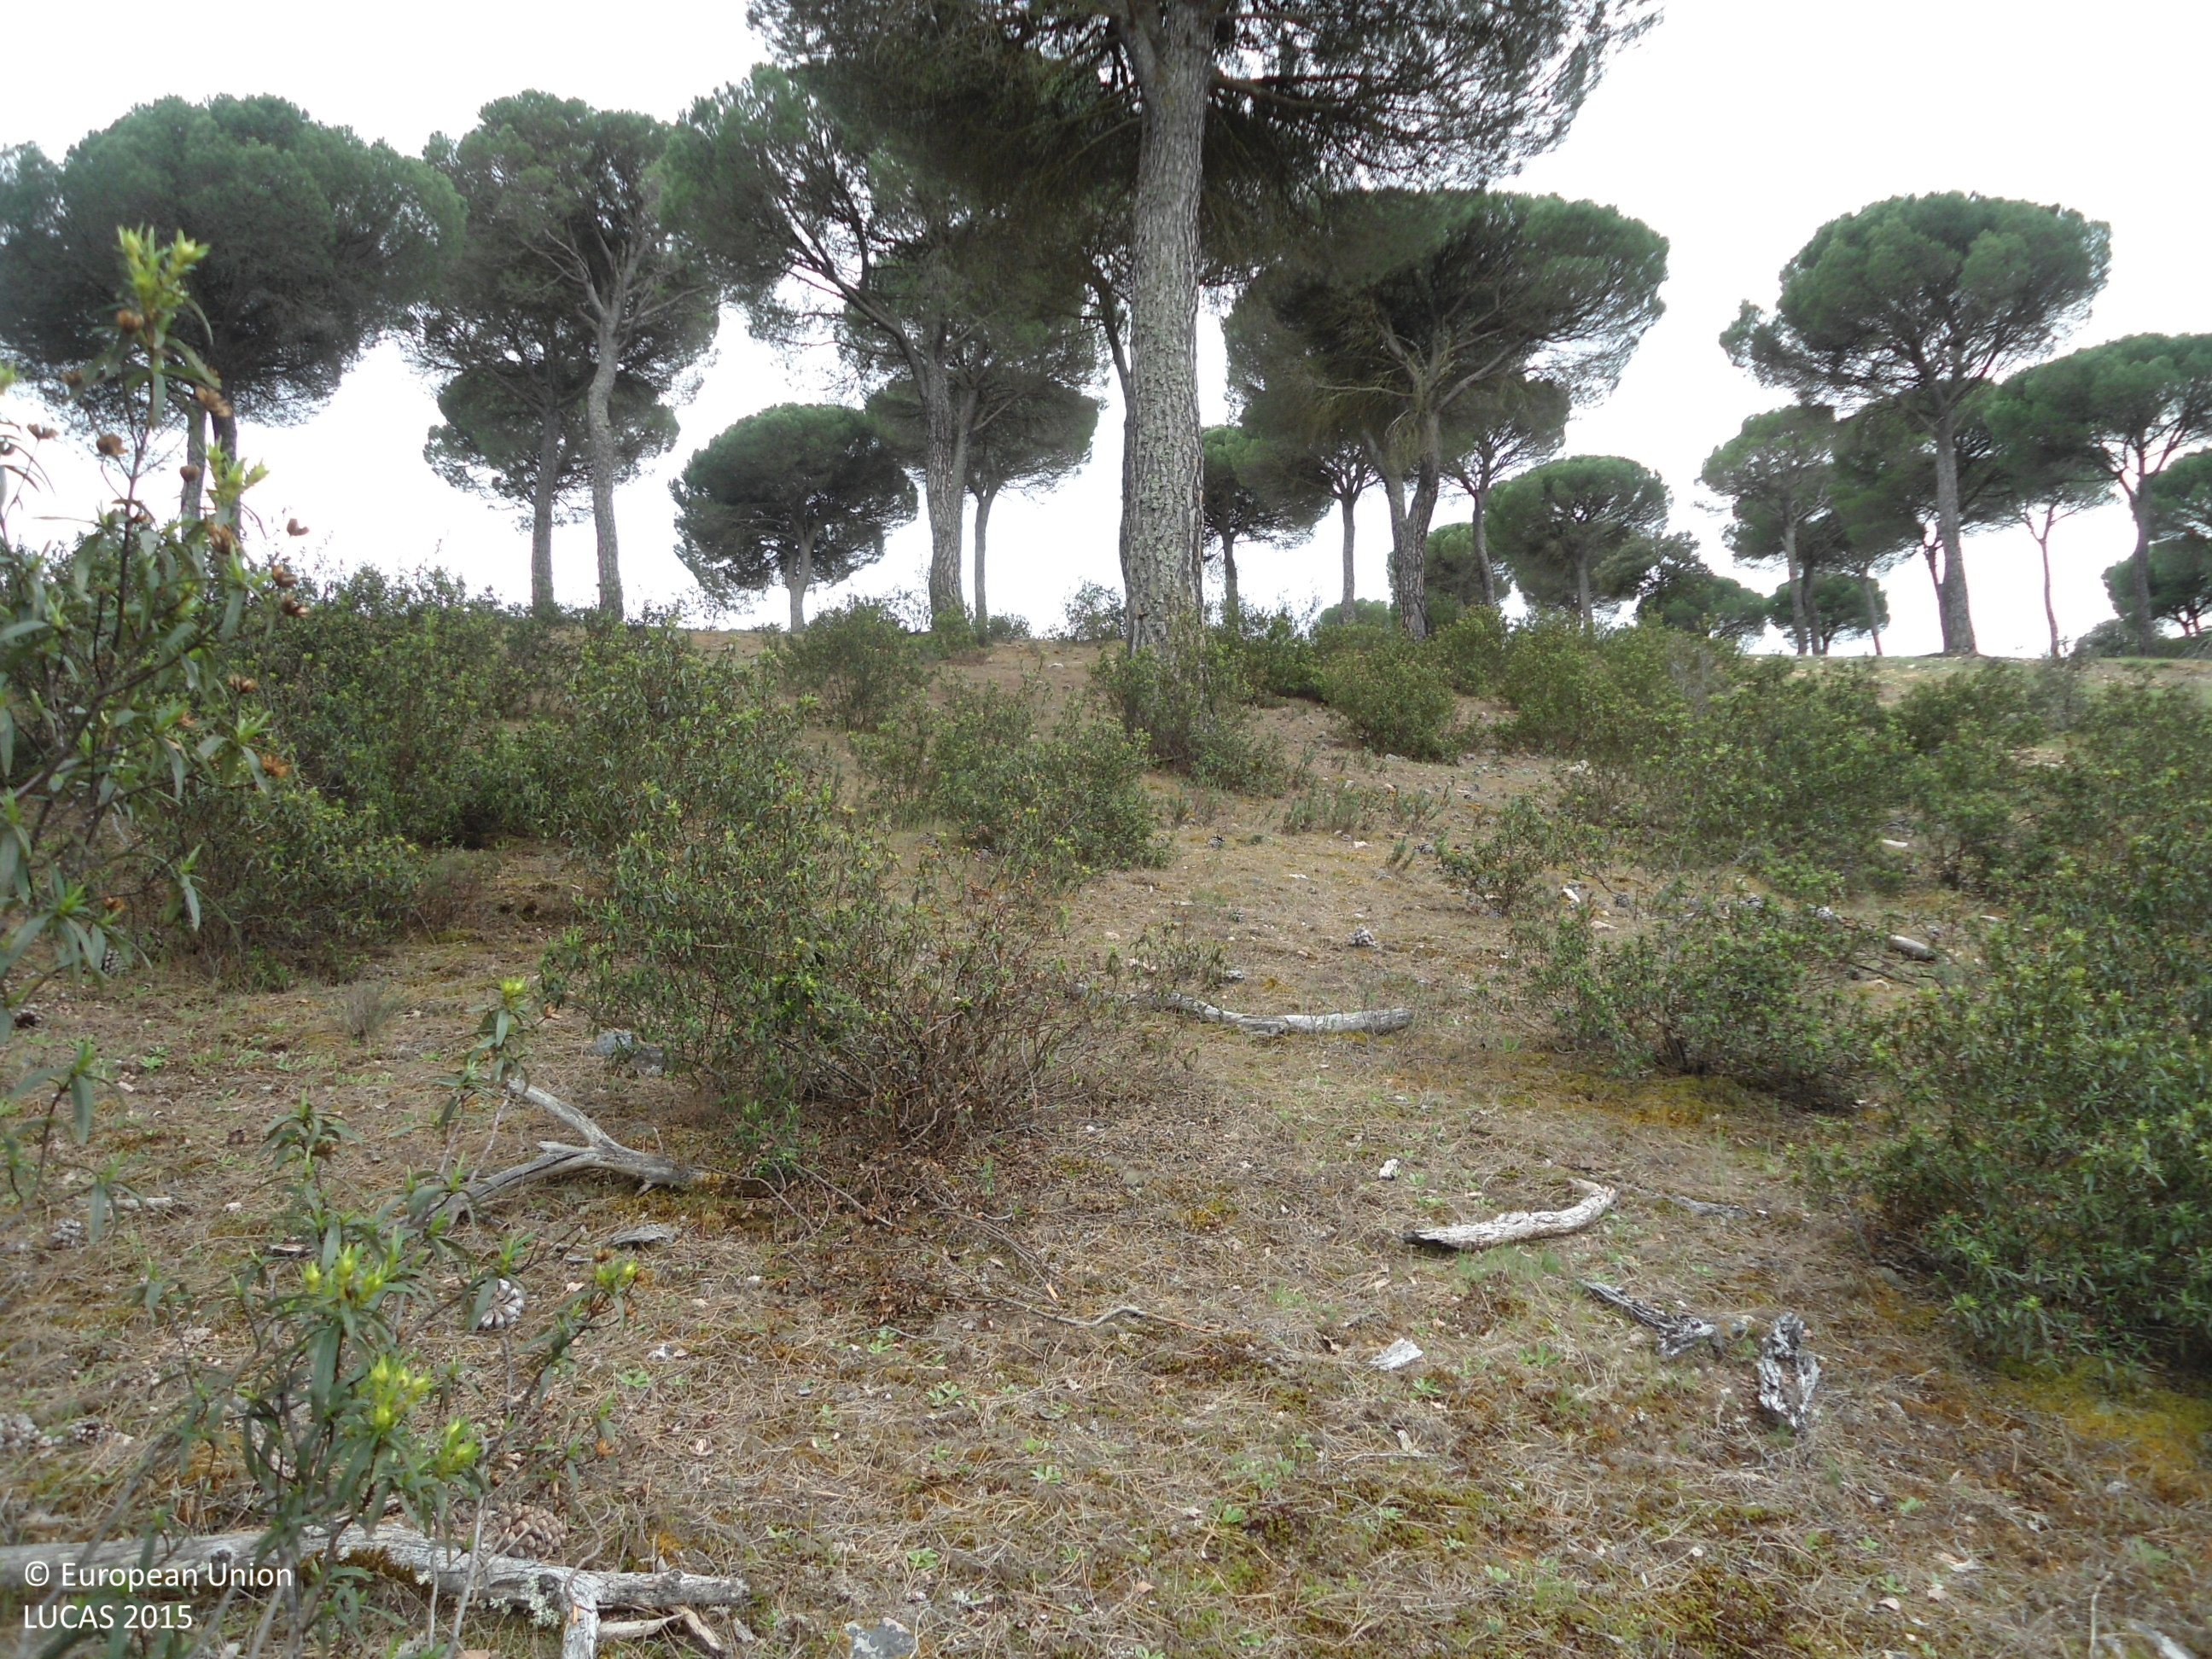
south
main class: Woodland
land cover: Pine dominated coniferous woodland
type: coniferous forest of the mediterranean region
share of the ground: > 75 %
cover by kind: coniferous forest trees 80 %, shrubs 10 %, herbaceous plants 10 %
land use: Agriculture (excluding fallow land and kitchen gardens)
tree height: > 5 m
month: April
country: ES
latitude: 41.5470
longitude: -5.8292
